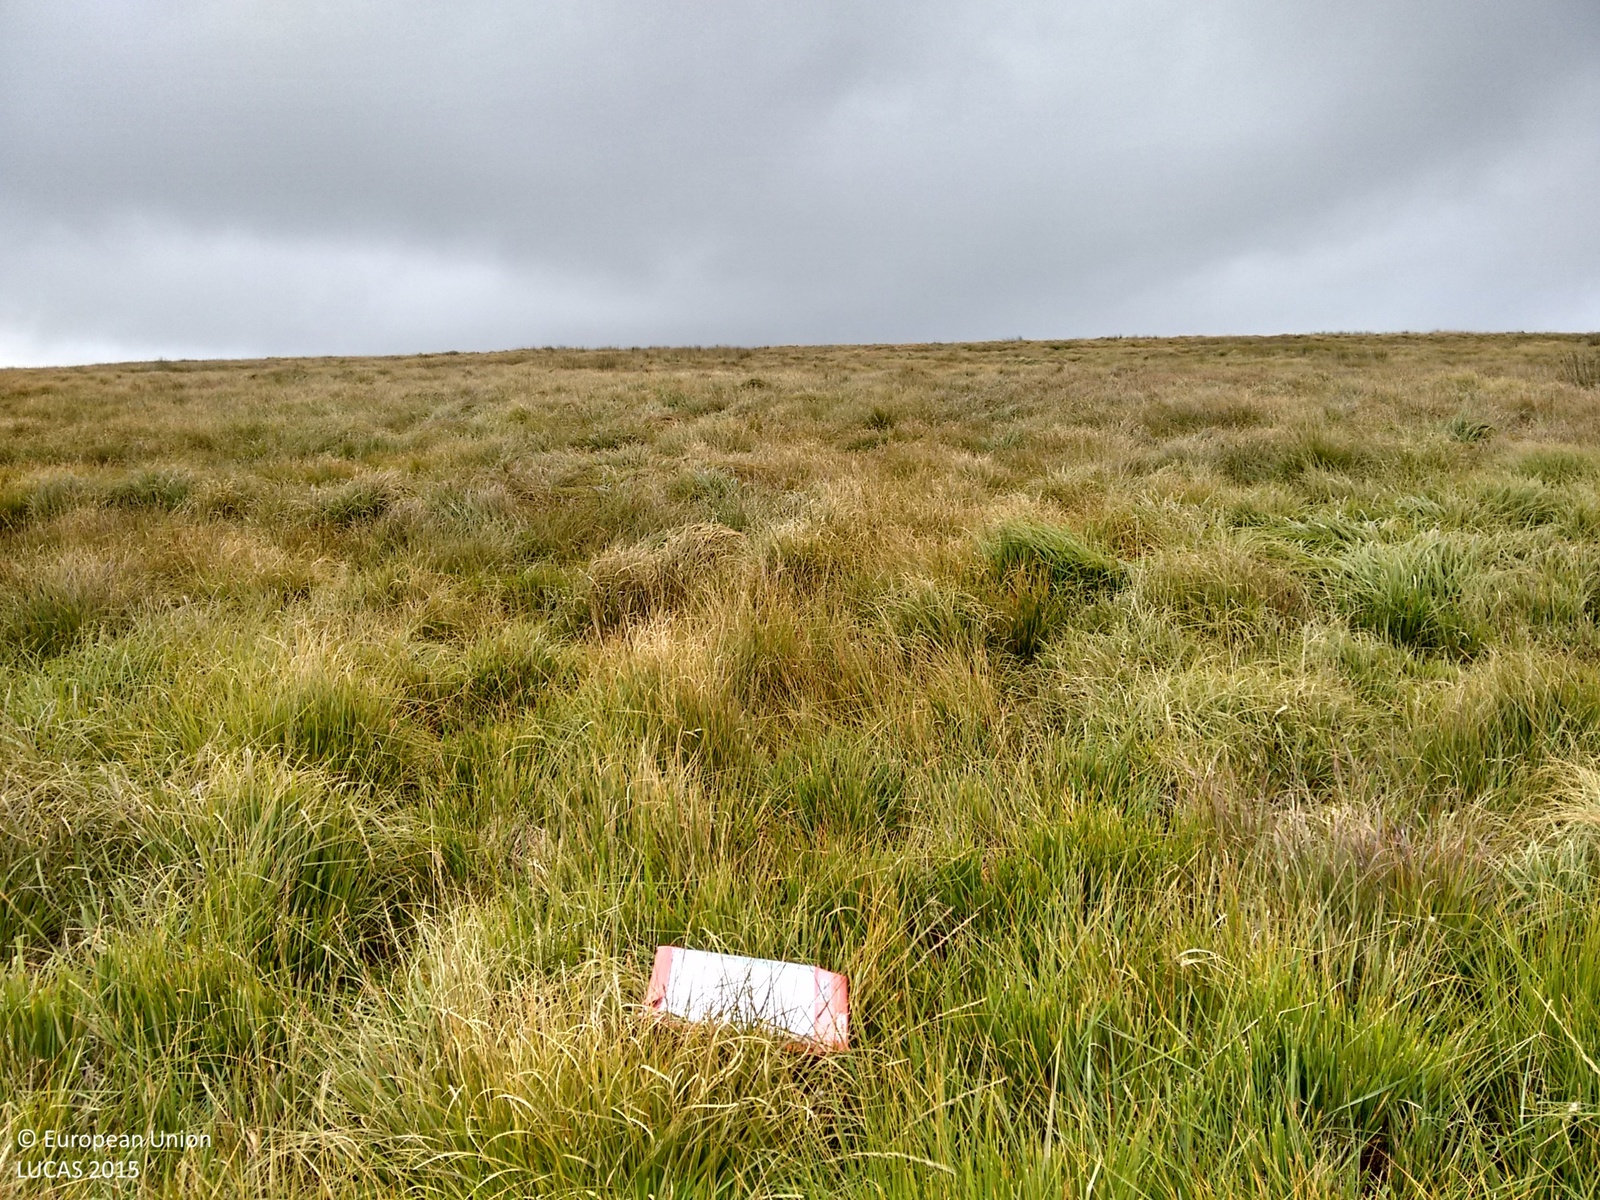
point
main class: Grassland
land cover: Grassland without tree/shrub cover
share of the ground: > 75 %
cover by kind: herbaceous plants 100 %
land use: Agriculture (excluding fallow land and kitchen gardens)
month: September
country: GB
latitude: 52.2049
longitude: -3.8015
